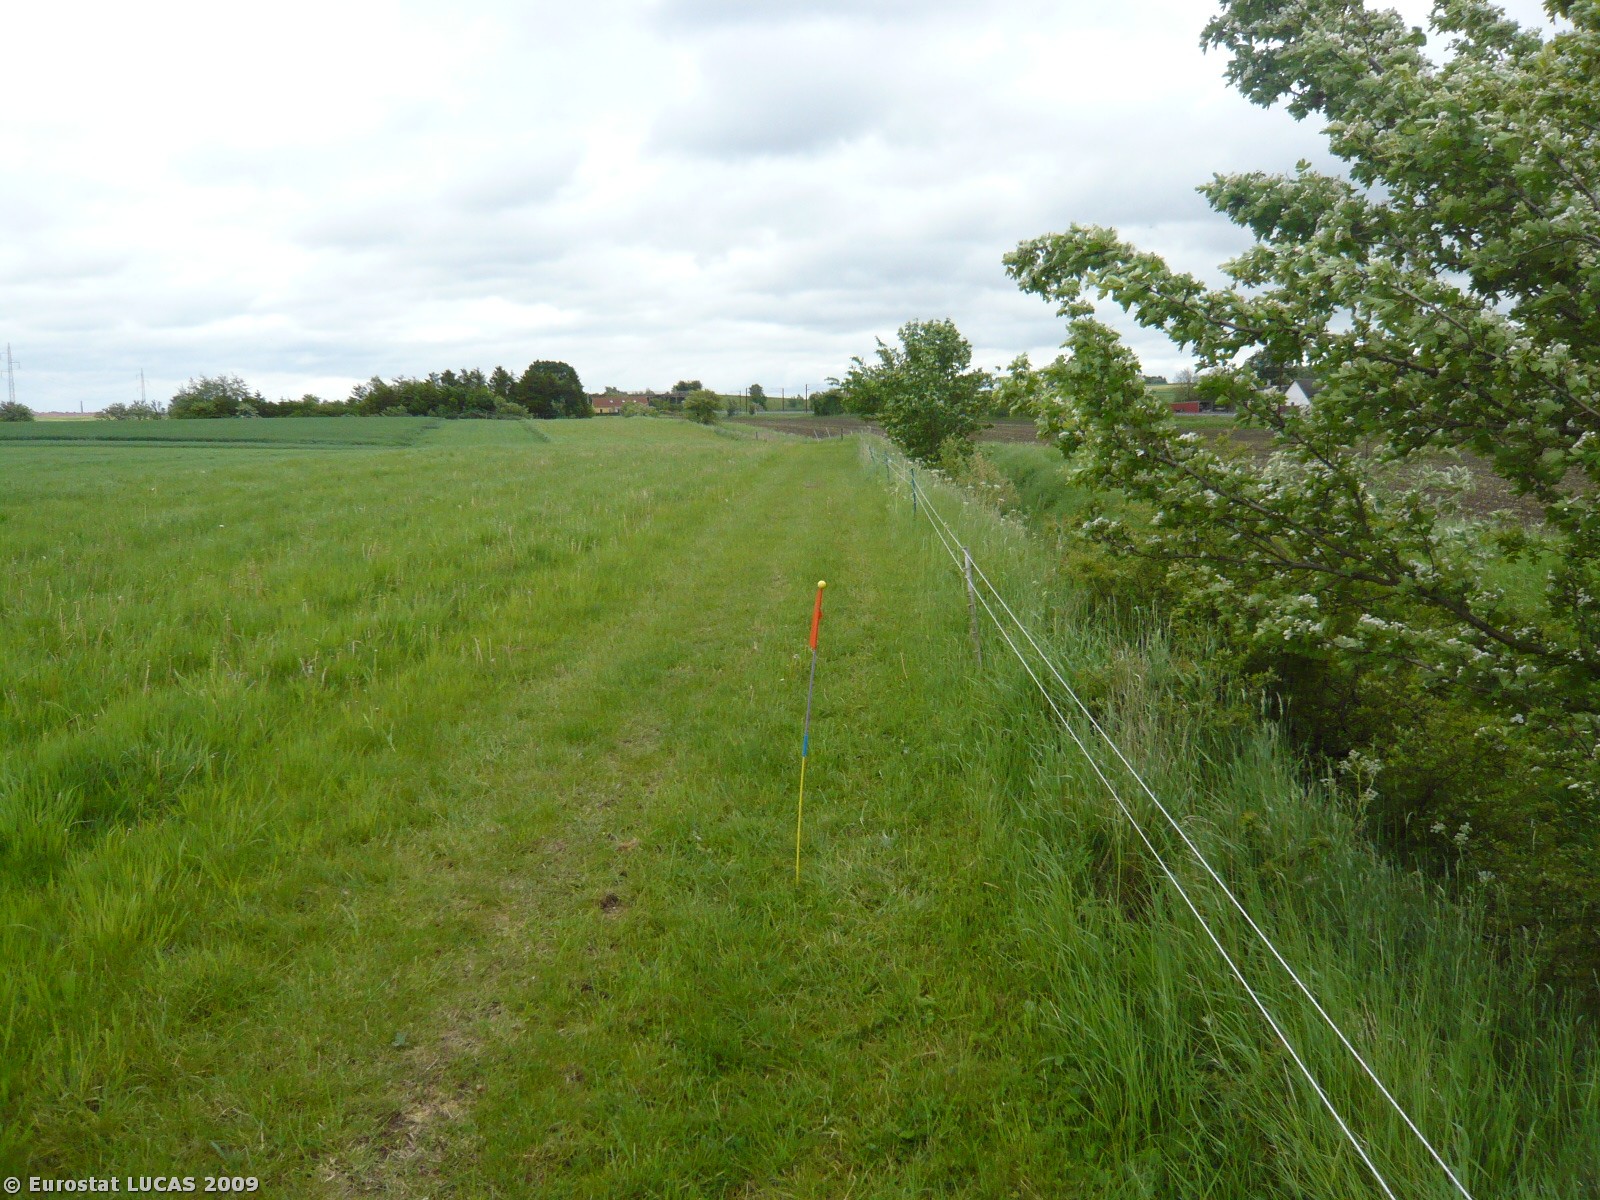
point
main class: Grassland
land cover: Grassland without tree/shrub cover
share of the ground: > 75 %
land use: Agriculture (excluding fallow land and kitchen gardens)
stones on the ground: < 10 %
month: May
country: DK
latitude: 55.4391
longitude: 11.7214
